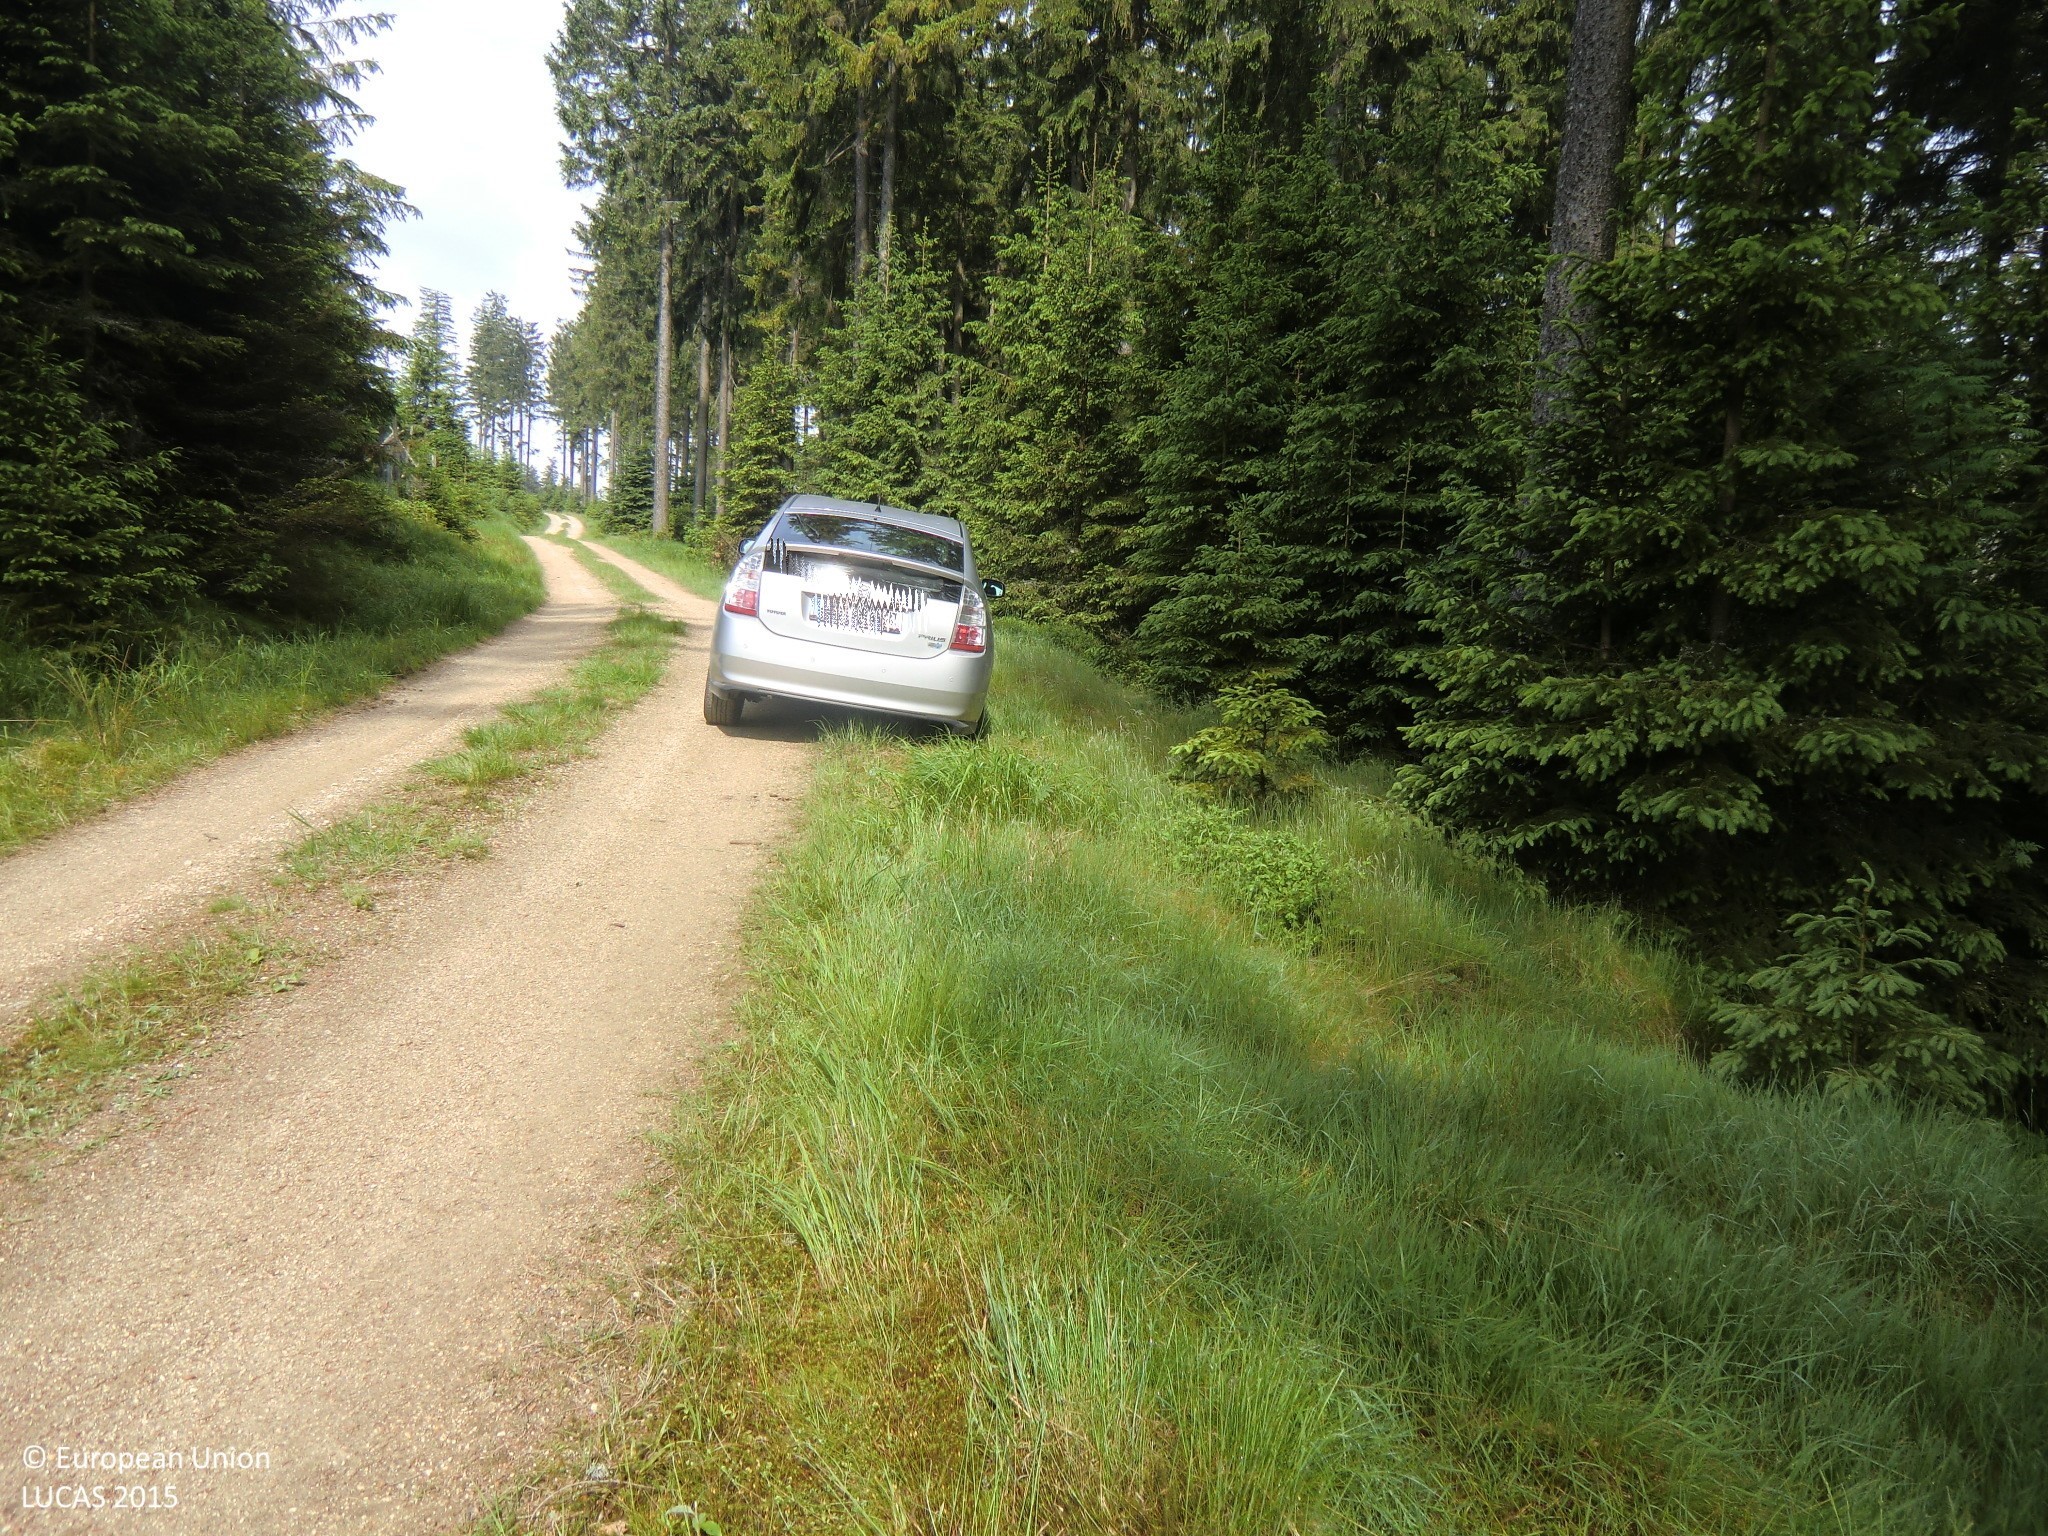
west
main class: Woodland
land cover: Other coniferous woodland
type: hemiboreal forest and nemoral coniferous forest and mixed broadleaved-coniferous forest
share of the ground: > 75 %
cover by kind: coniferous forest trees 75 %, herbaceous plants 15 %, lichens and mosses 10 %
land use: Forestry
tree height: > 5 m
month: June
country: AT
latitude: 48.6085
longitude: 14.7346
